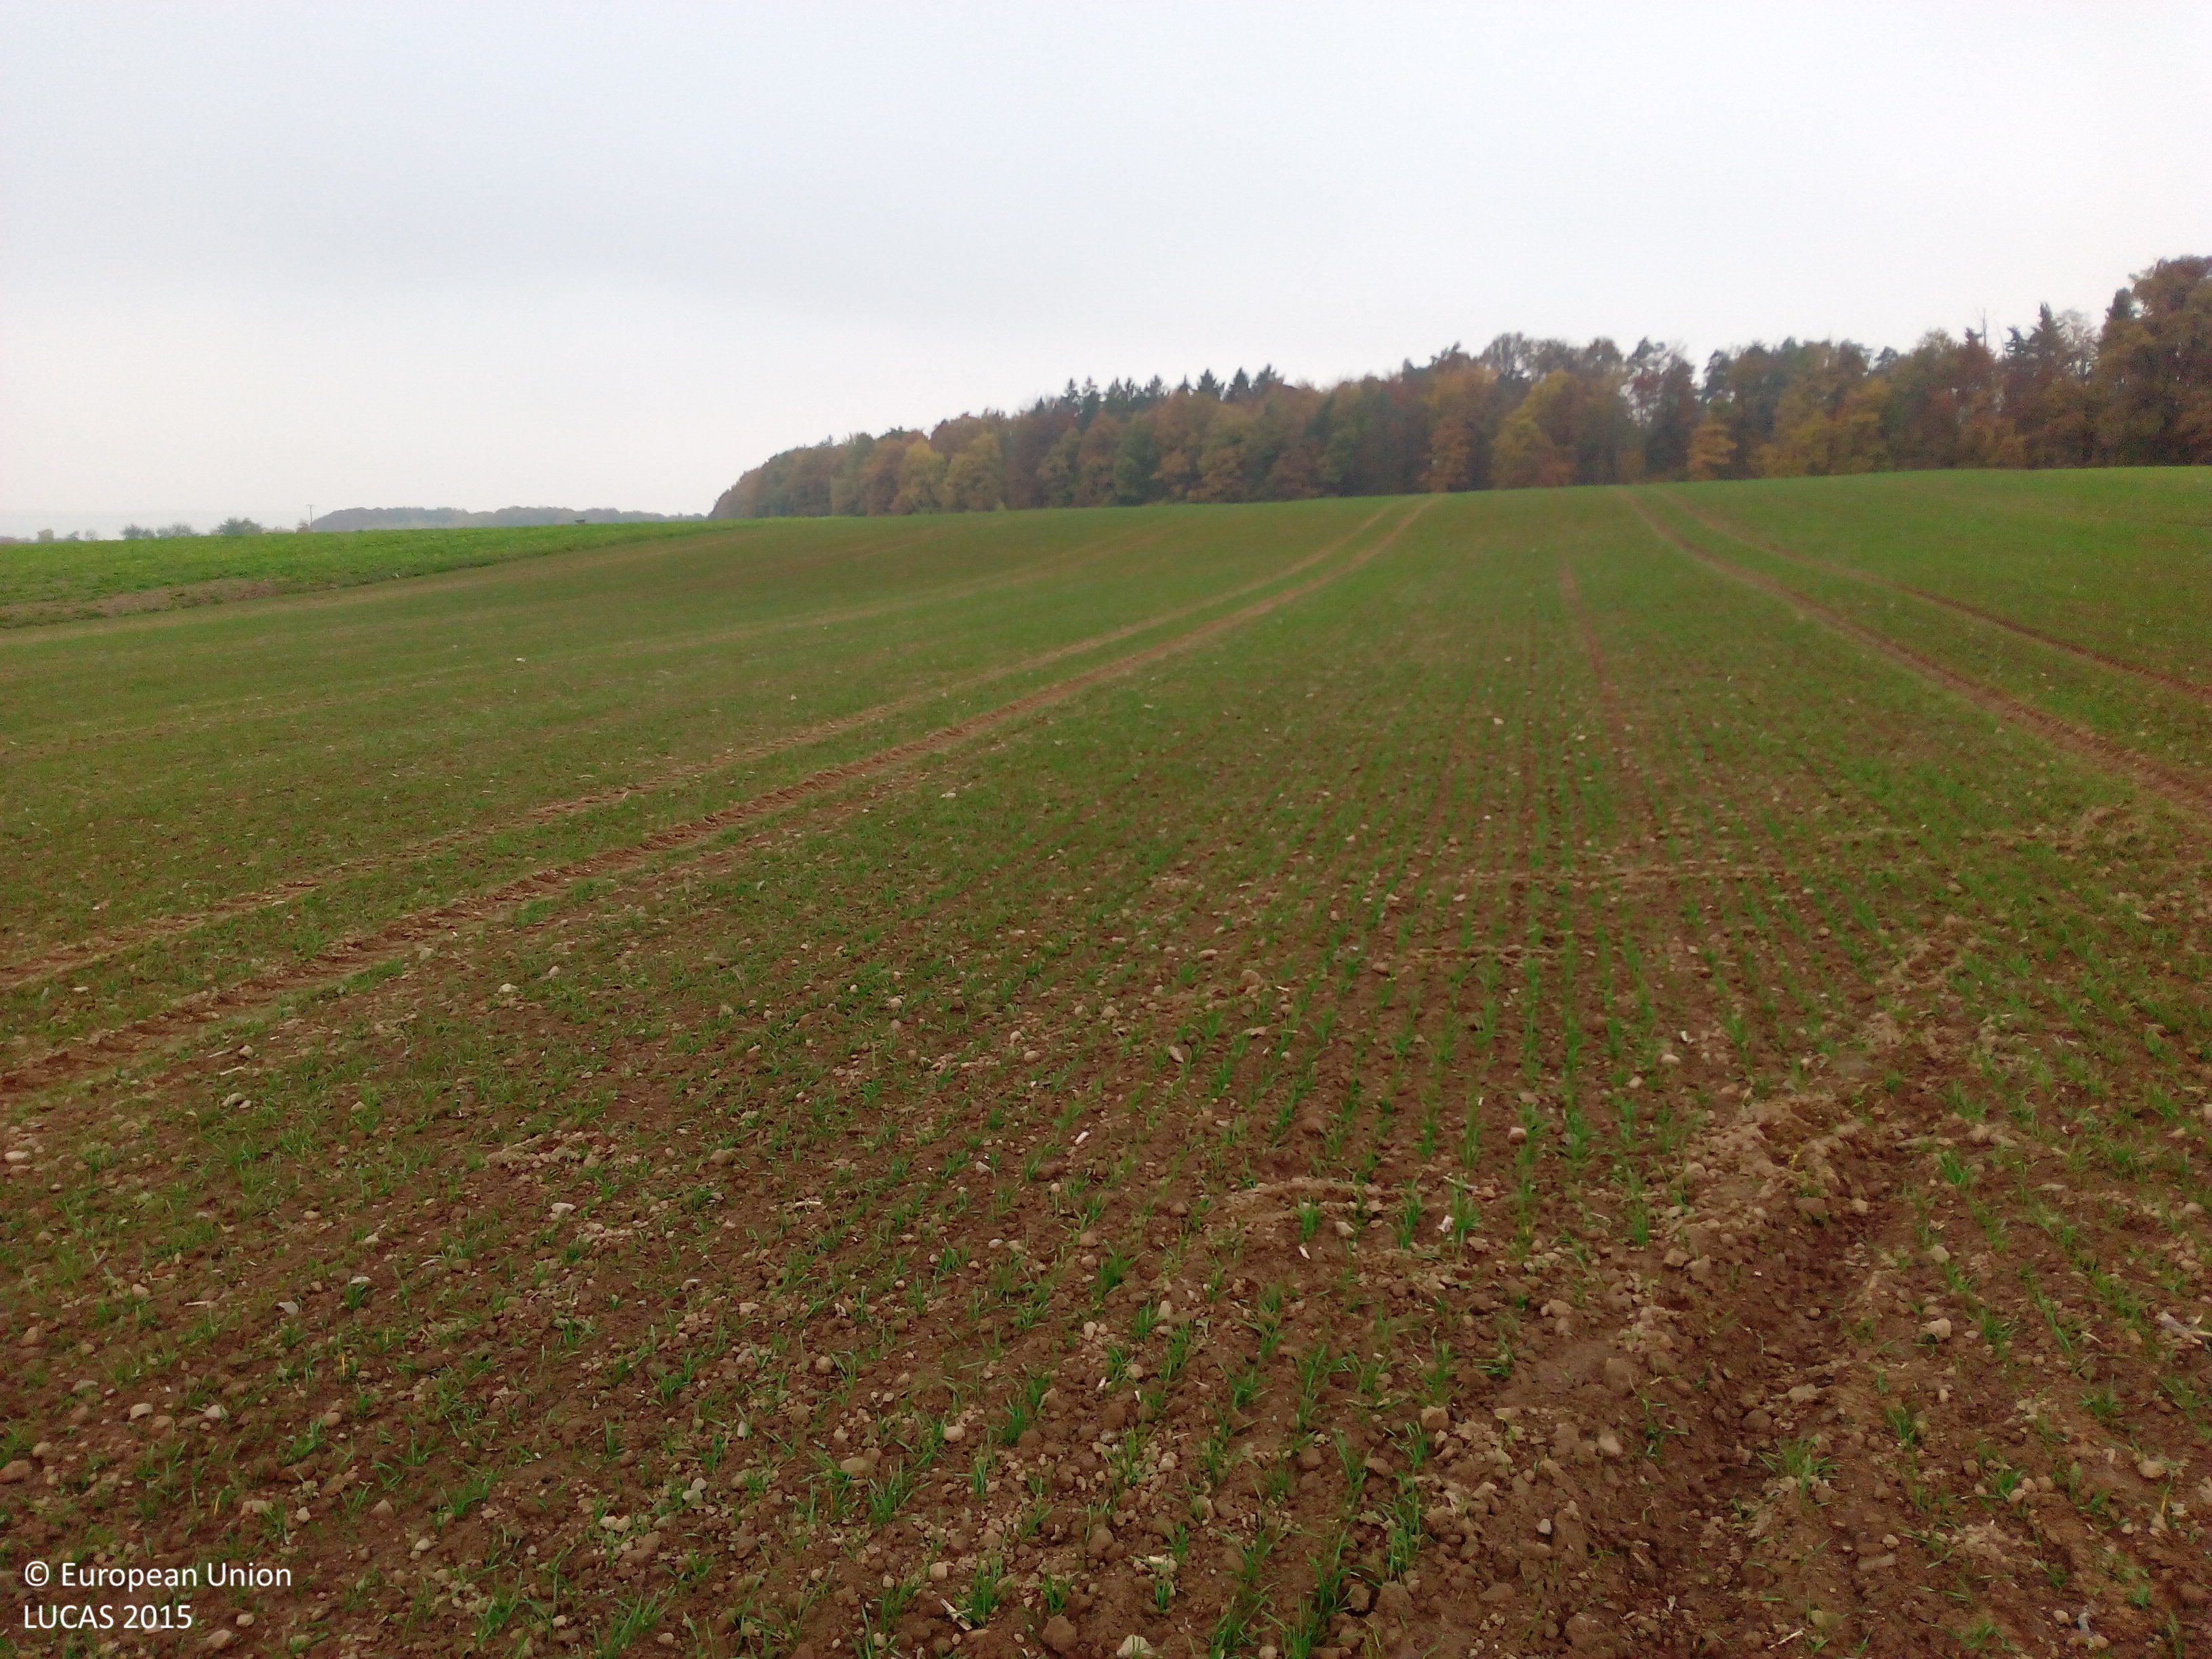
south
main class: Cropland
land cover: Common wheat
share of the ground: < 10 %
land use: Agriculture (excluding fallow land and kitchen gardens)
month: October
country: DE
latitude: 50.2382
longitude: 9.9580
